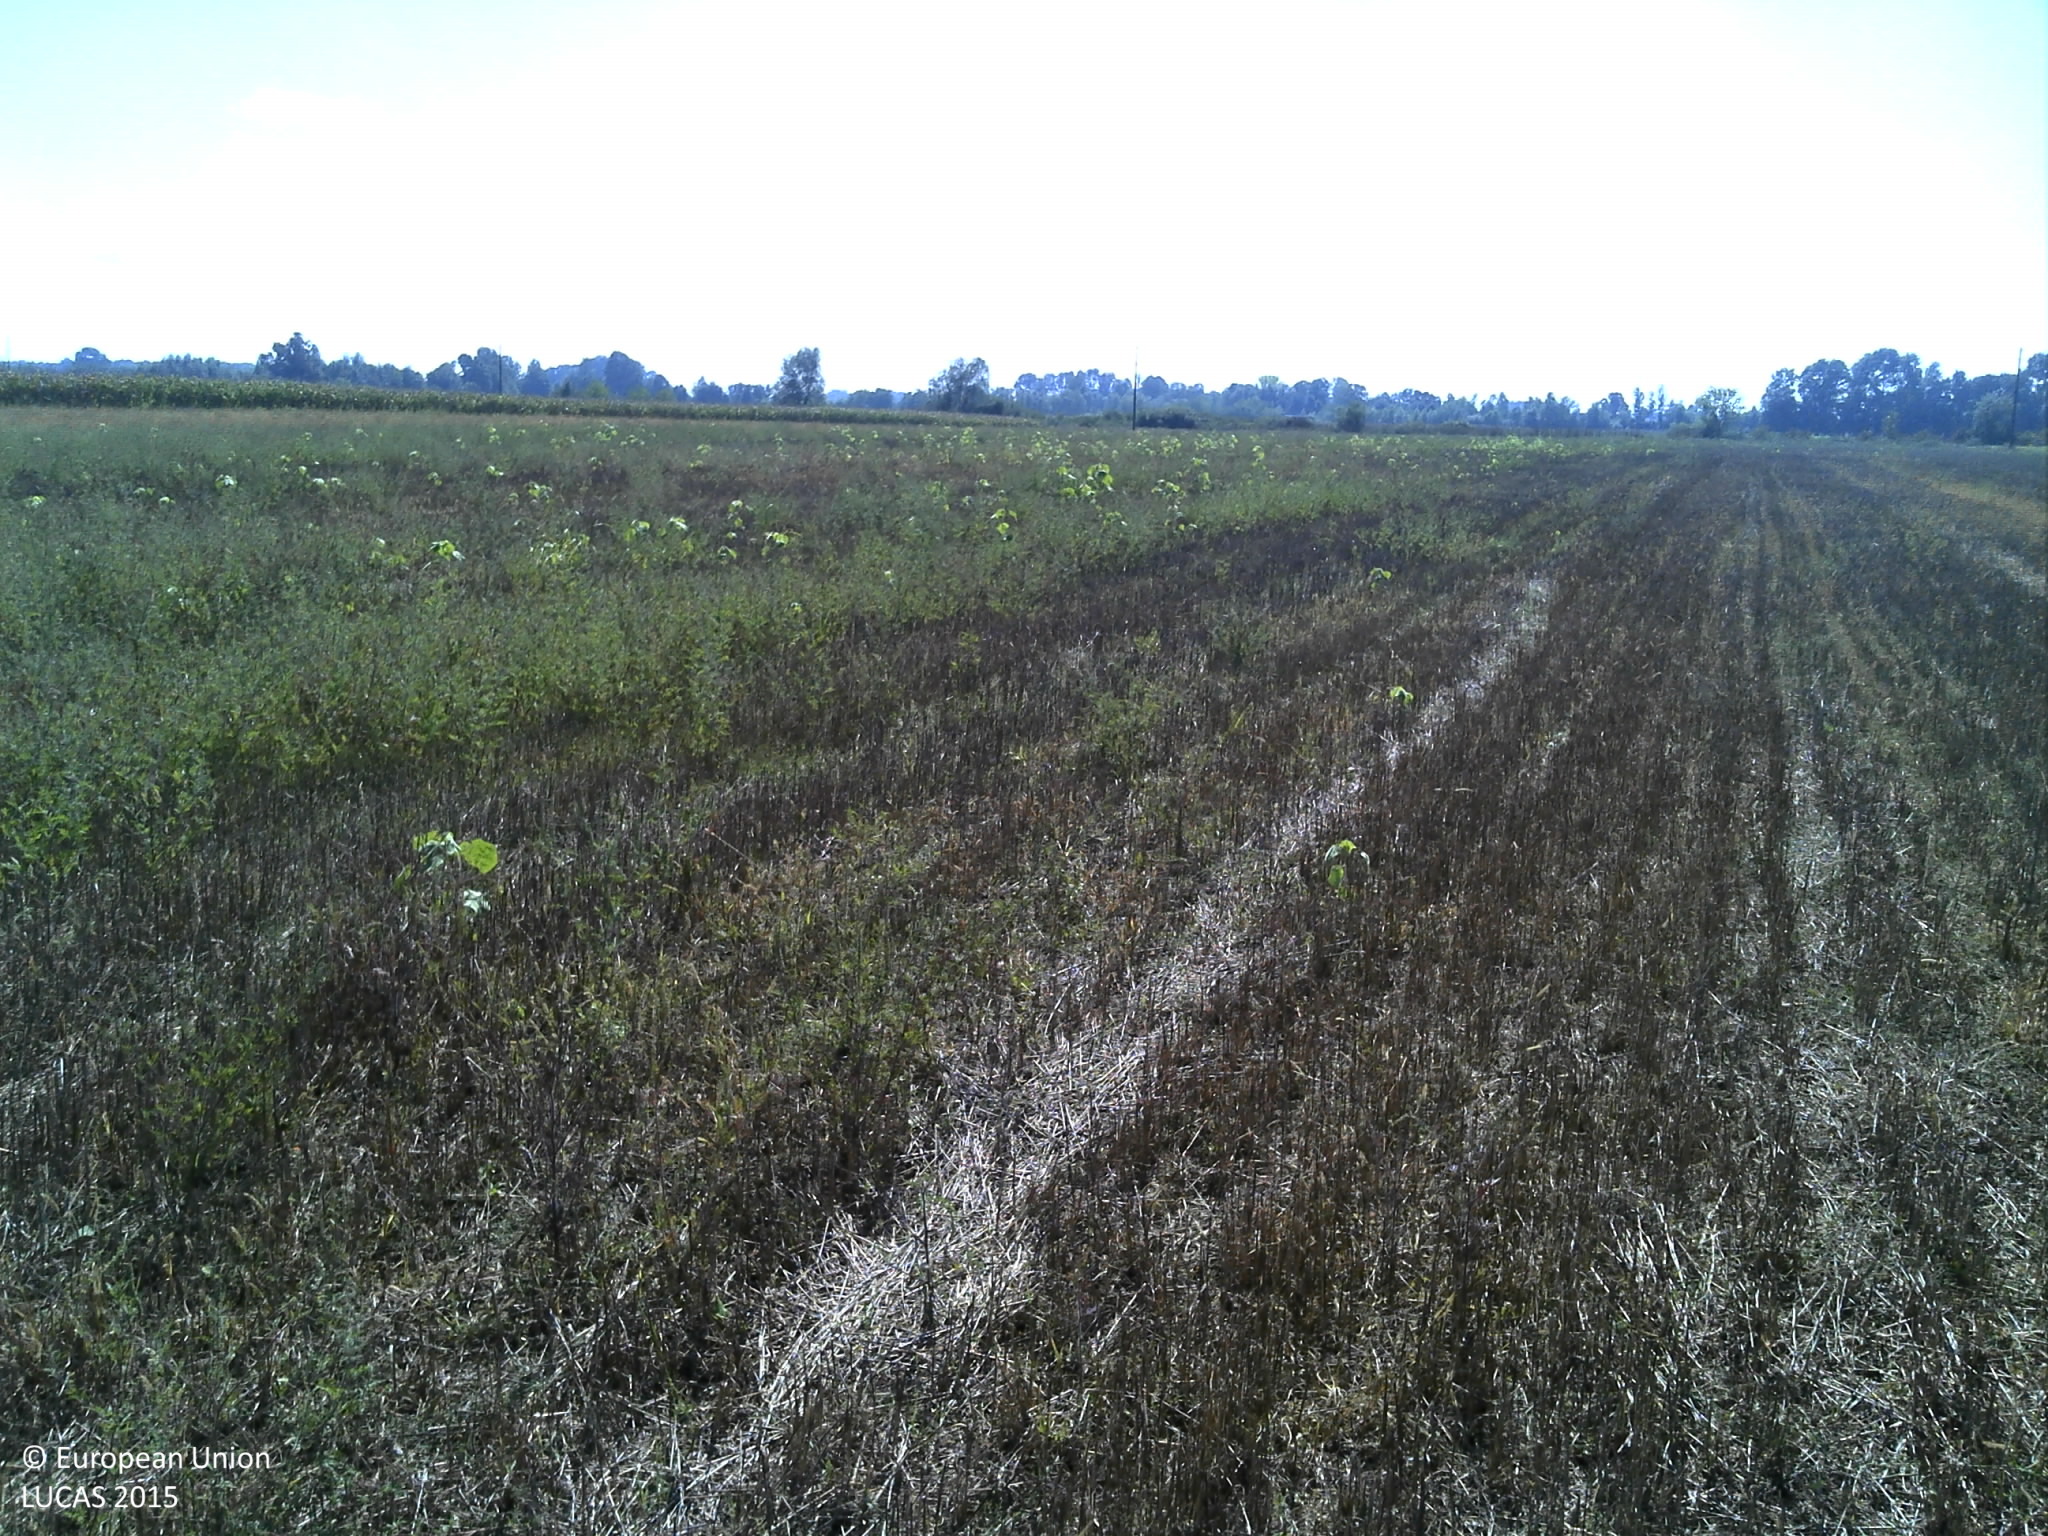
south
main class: Cropland
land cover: Common wheat
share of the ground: > 75 %
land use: Agriculture (excluding fallow land and kitchen gardens)
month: September
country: HR
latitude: 45.1358
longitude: 18.5885
